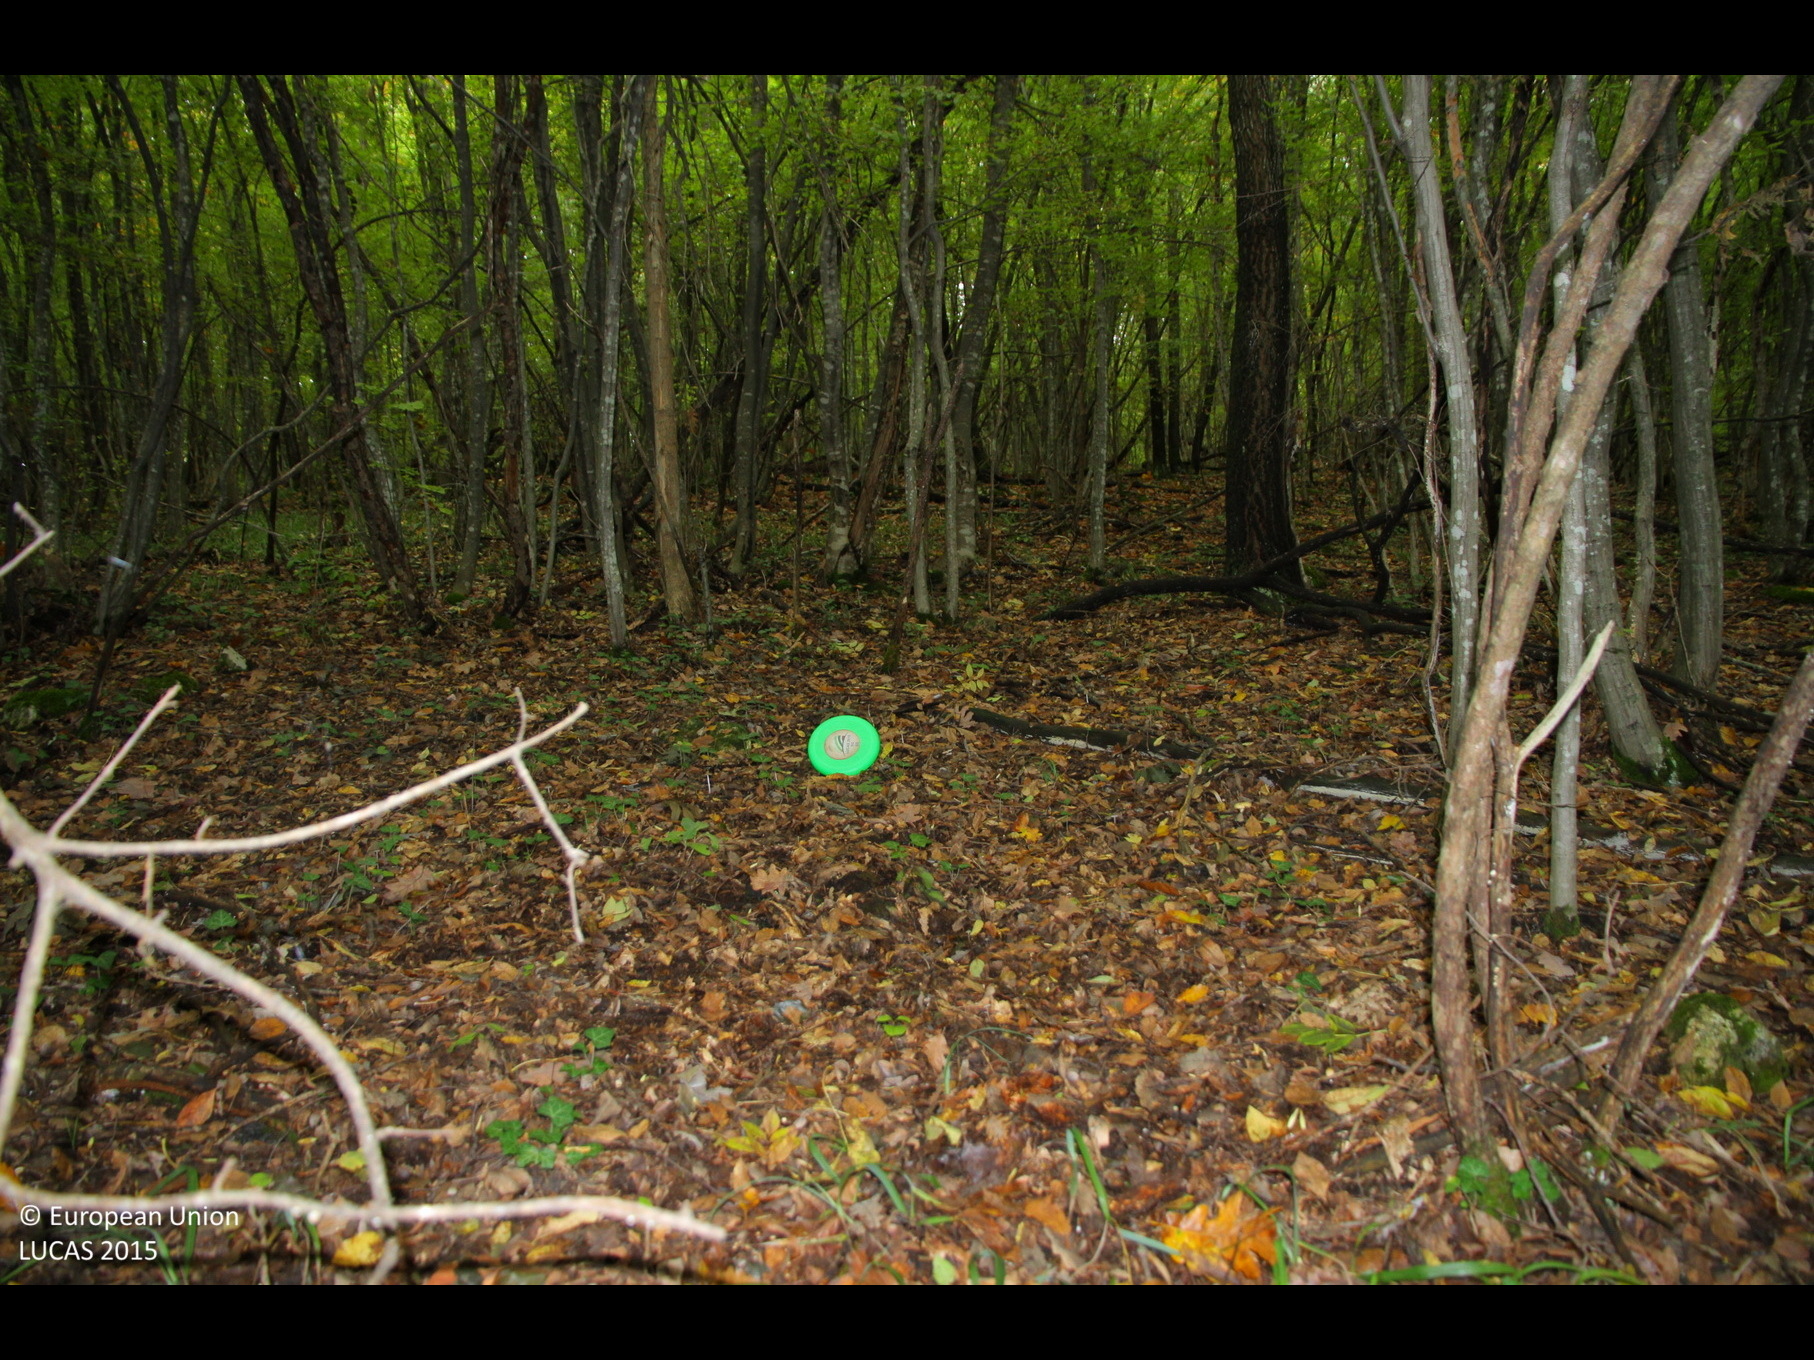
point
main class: Woodland
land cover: Broadleaved woodland
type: beech forest
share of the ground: > 75 %
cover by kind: broadleaved forest trees 100 %
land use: Forestry
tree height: > 5 m
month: October
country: BG
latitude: 43.4718
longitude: 27.0922
